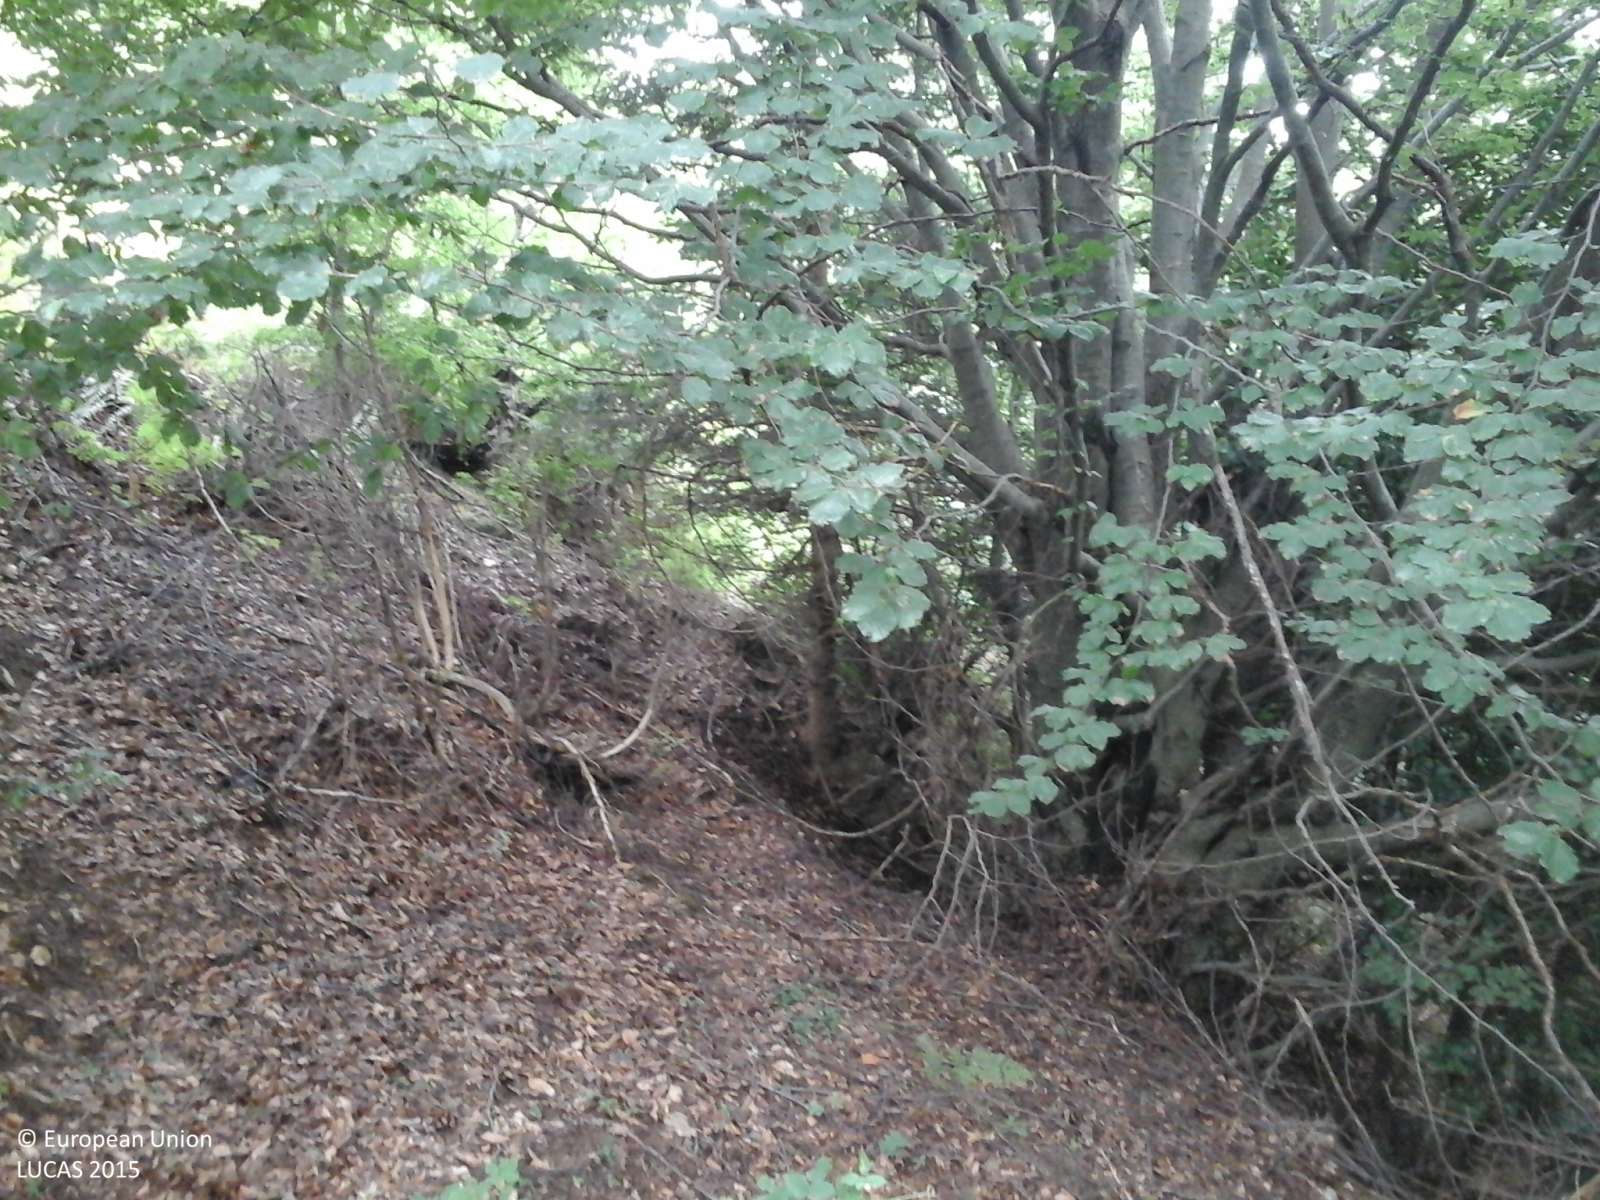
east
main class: Woodland
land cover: Broadleaved woodland
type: mountainous beech forest
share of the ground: > 75 %
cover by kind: broadleaved forest trees 80 %, coniferous forest trees 10 %, herbaceous plants 10 %
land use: Forestry
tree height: > 5 m
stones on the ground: < 10 %
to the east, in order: Broadleaved woodland; Tracks; Shrubland with sparse tree cover; Broadleaved woodland; Electric lines; Broadleaved woodland
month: August
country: IT
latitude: 46.0773
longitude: 9.1091
